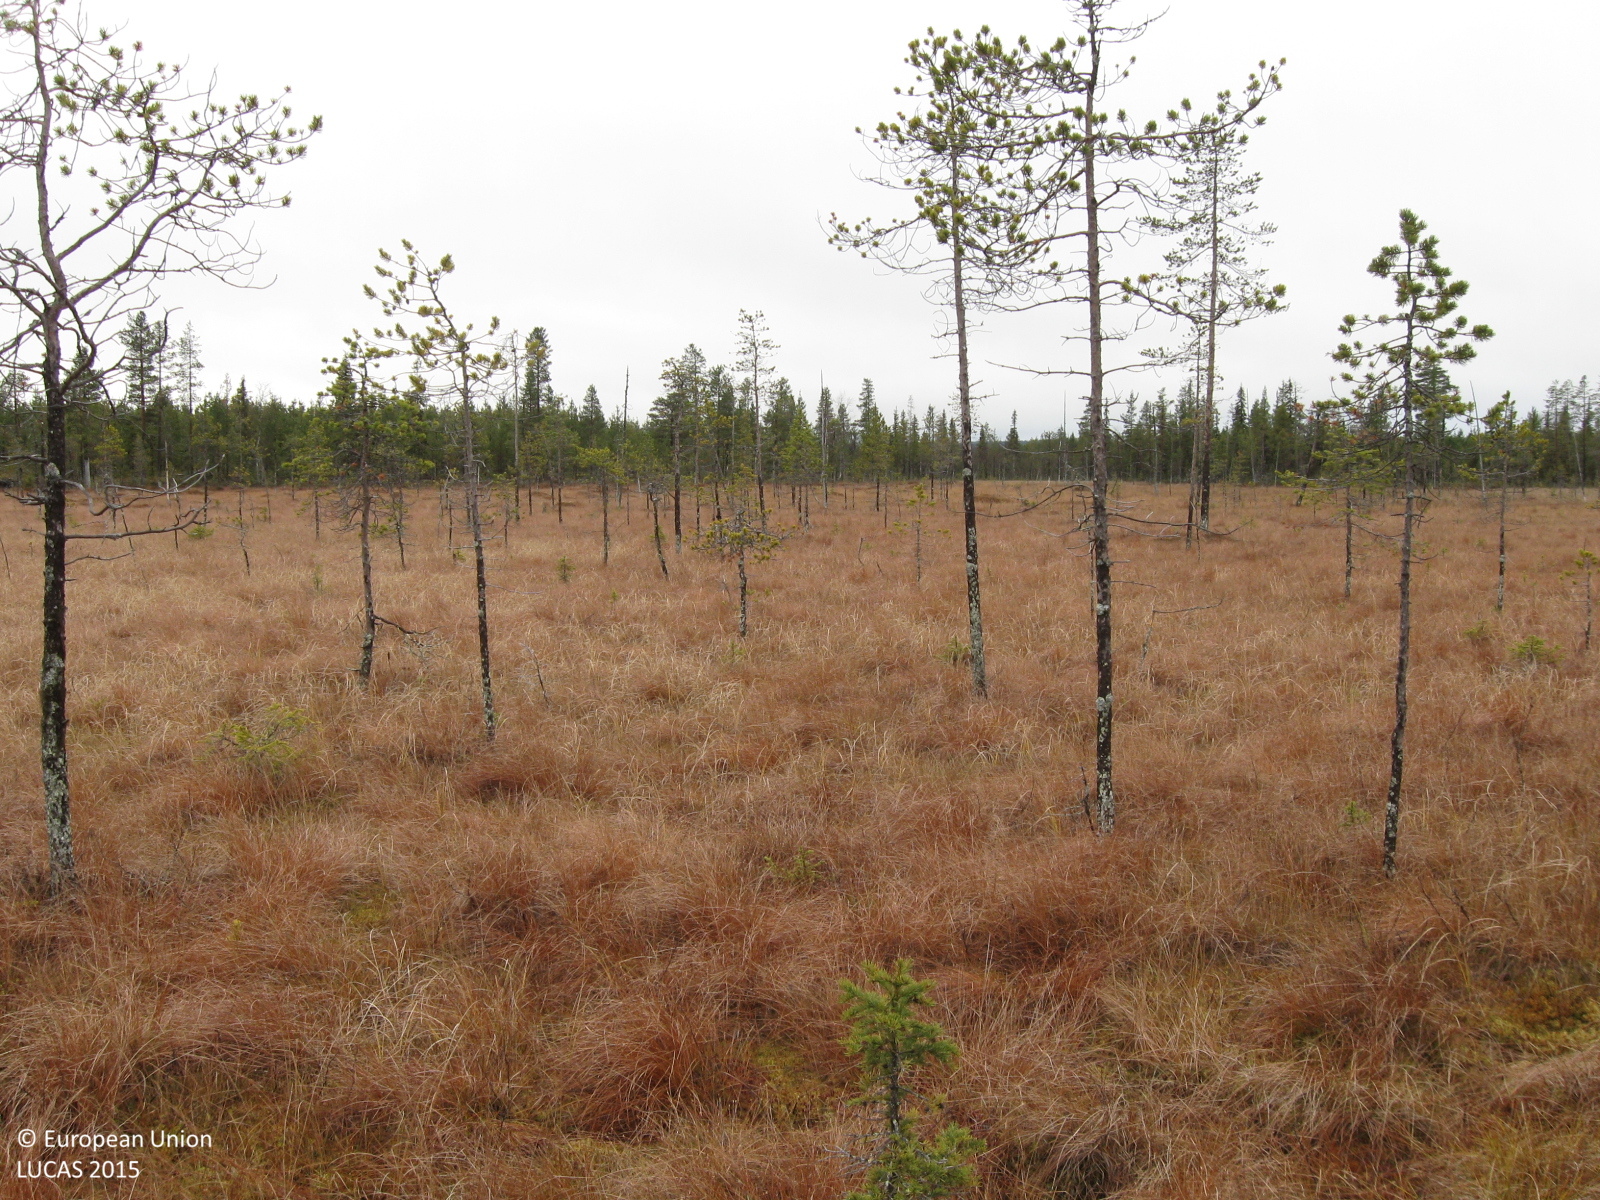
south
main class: Woodland
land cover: Pine dominated coniferous woodland
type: mire and swamp forests
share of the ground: 25 - 50 %
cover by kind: herbaceous plants 60 %, coniferous forest trees 25 %, lichens and mosses 10 %, shrubs 5 %
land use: Semi-natural and natural areas not in use
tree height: < 5 m
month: October
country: SE
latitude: 66.6479
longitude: 21.8326
